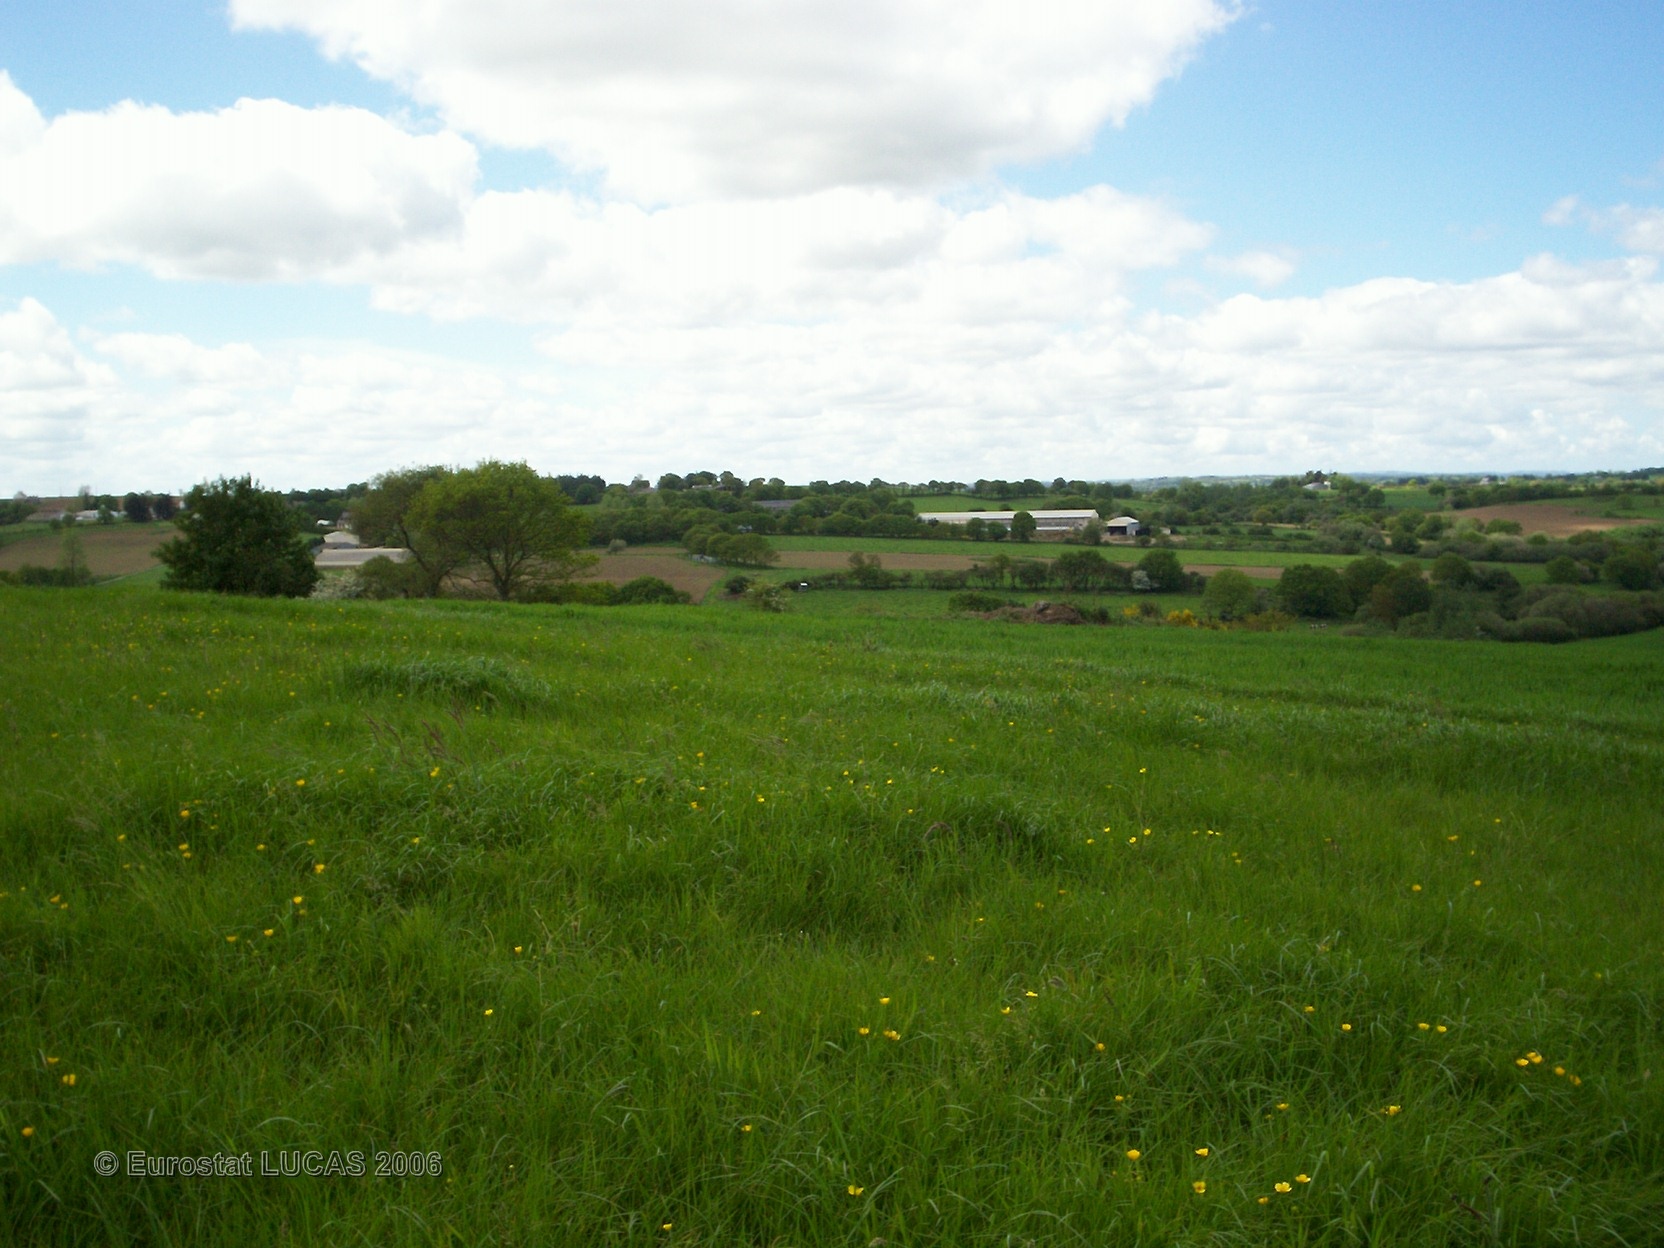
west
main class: Grassland
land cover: Grassland without tree/shrub cover
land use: Agriculture (excluding fallow land and kitchen gardens)
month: May
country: FR
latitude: 48.4125
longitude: -3.0266
